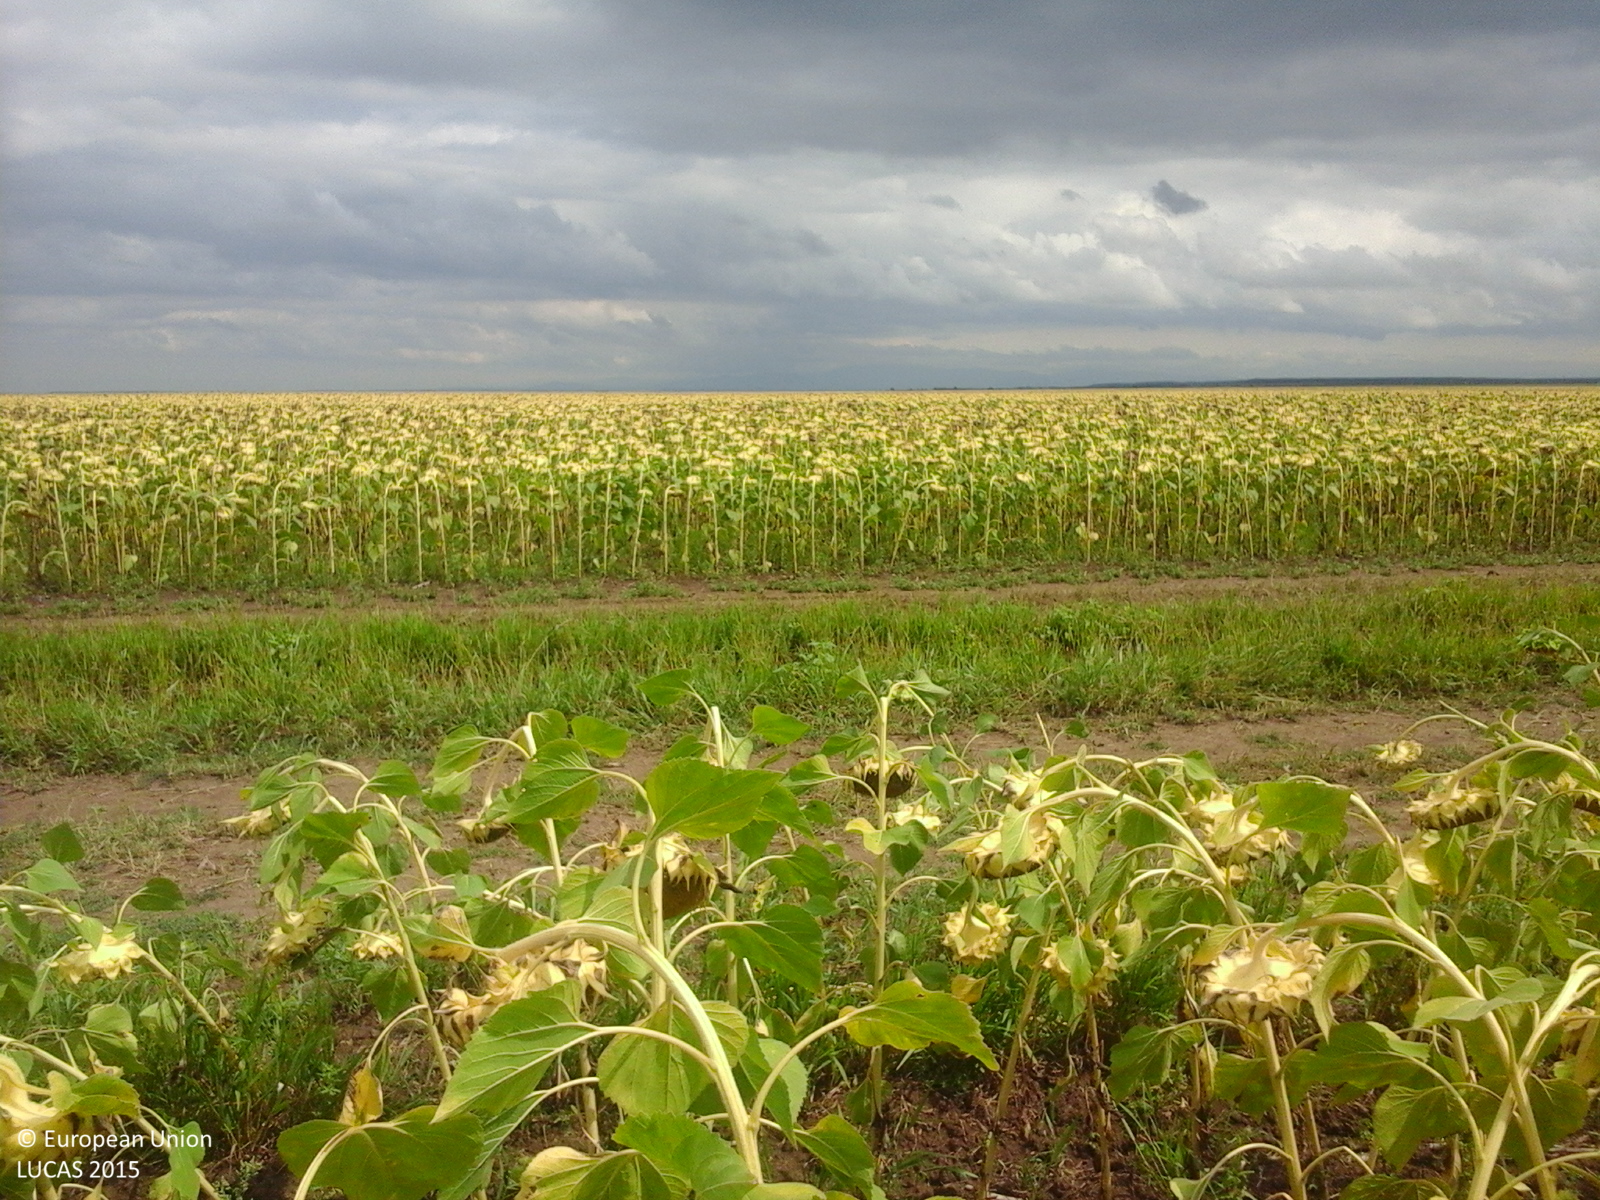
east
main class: Cropland
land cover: Sunflower
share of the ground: > 75 %
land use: Agriculture (excluding fallow land and kitchen gardens)
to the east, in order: Sunflower; Tracks; Grass margins; Ditches and canals; Grass margins; Tracks; Grass margins; Sunflower
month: August
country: RO
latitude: 45.6839
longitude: 21.5770
